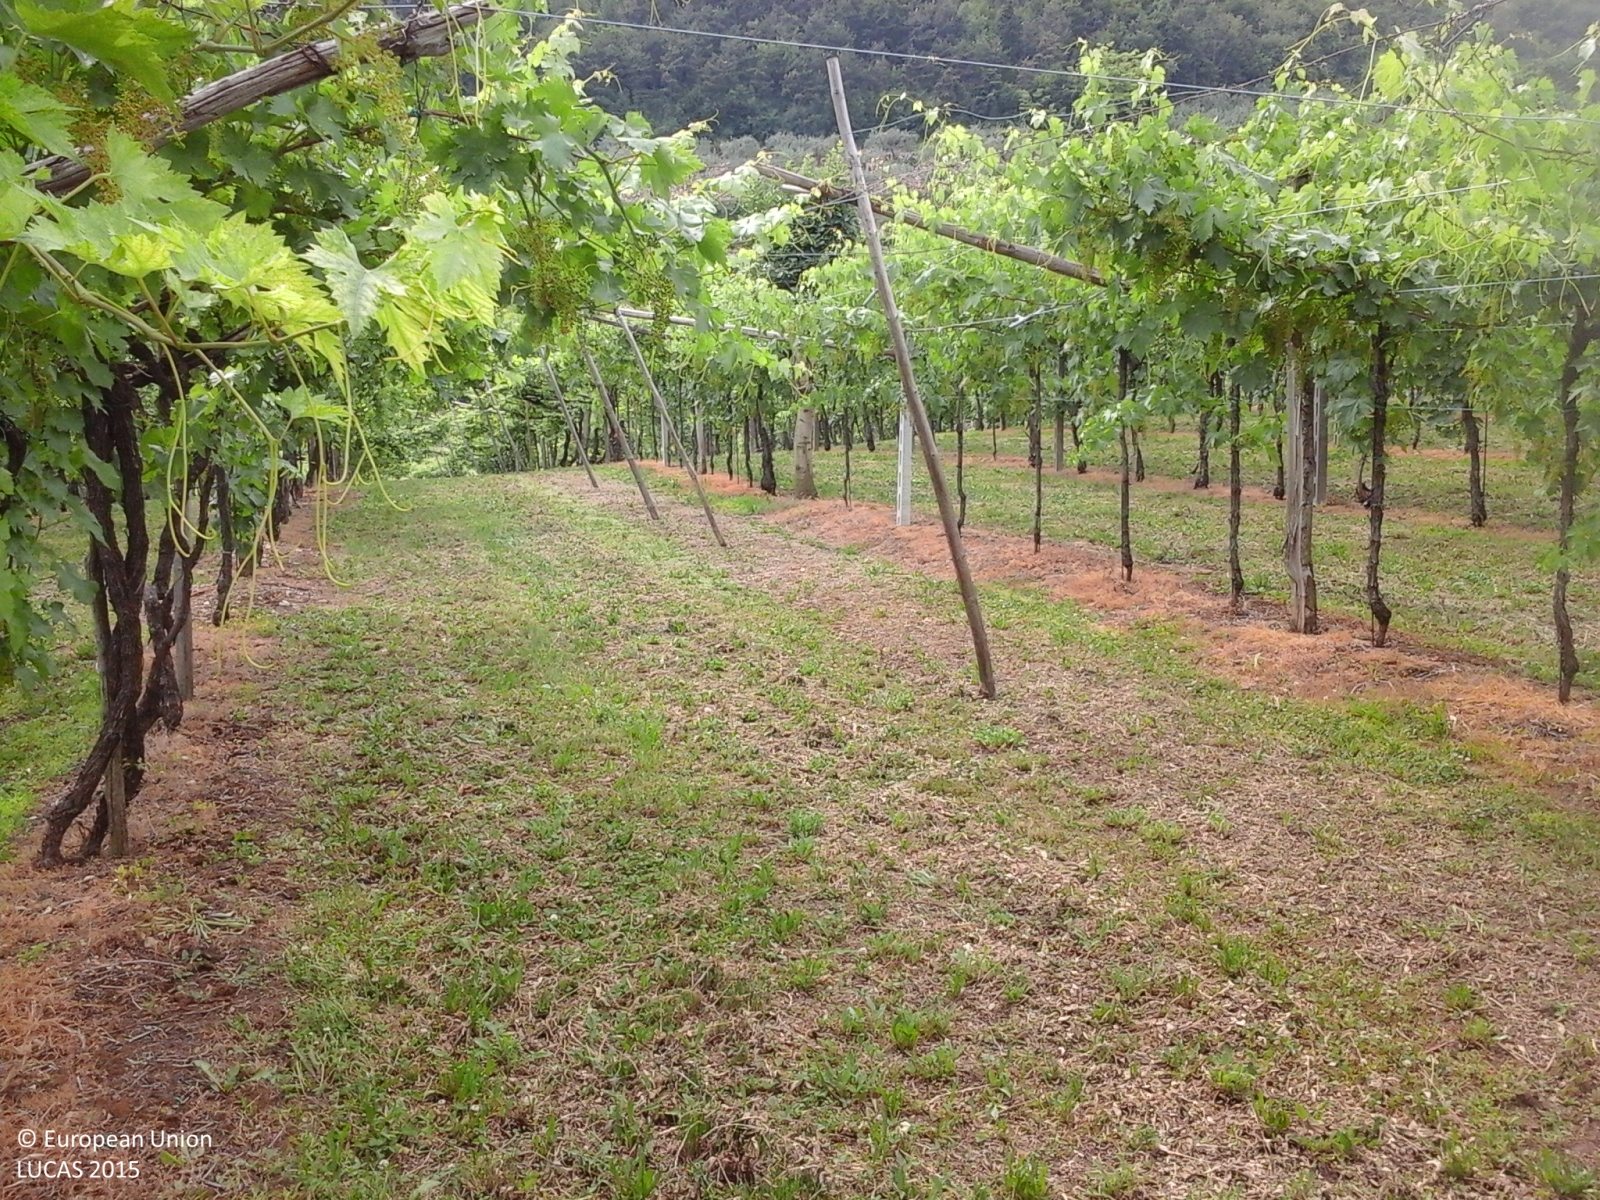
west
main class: Cropland
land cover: Vineyards
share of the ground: > 75 %
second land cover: Grassland without tree/shrub cover
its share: > 75 %
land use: Agriculture (excluding fallow land and kitchen gardens)
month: June
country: IT
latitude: 45.5363
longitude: 10.9333
